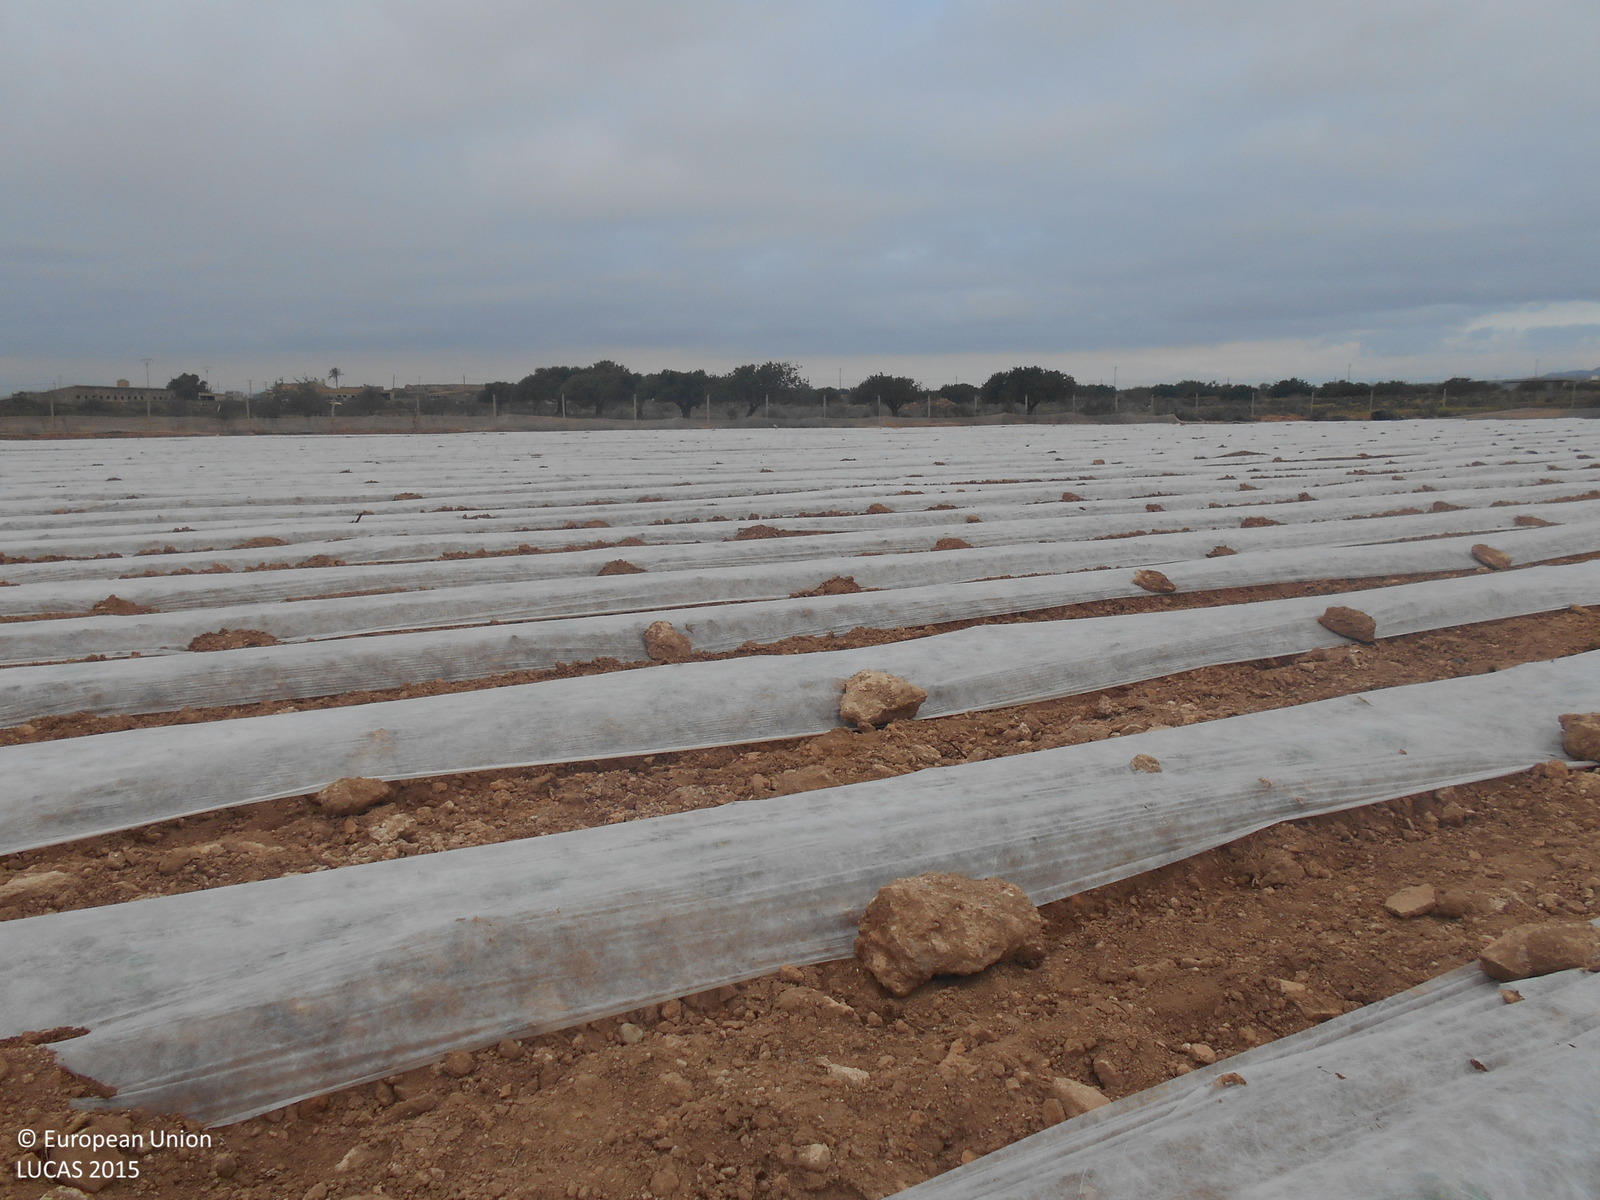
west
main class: Cropland
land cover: Other fresh vegetables
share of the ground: < 10 %
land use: Agriculture (excluding fallow land and kitchen gardens)
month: April
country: ES
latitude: 37.7570
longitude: -1.2298
